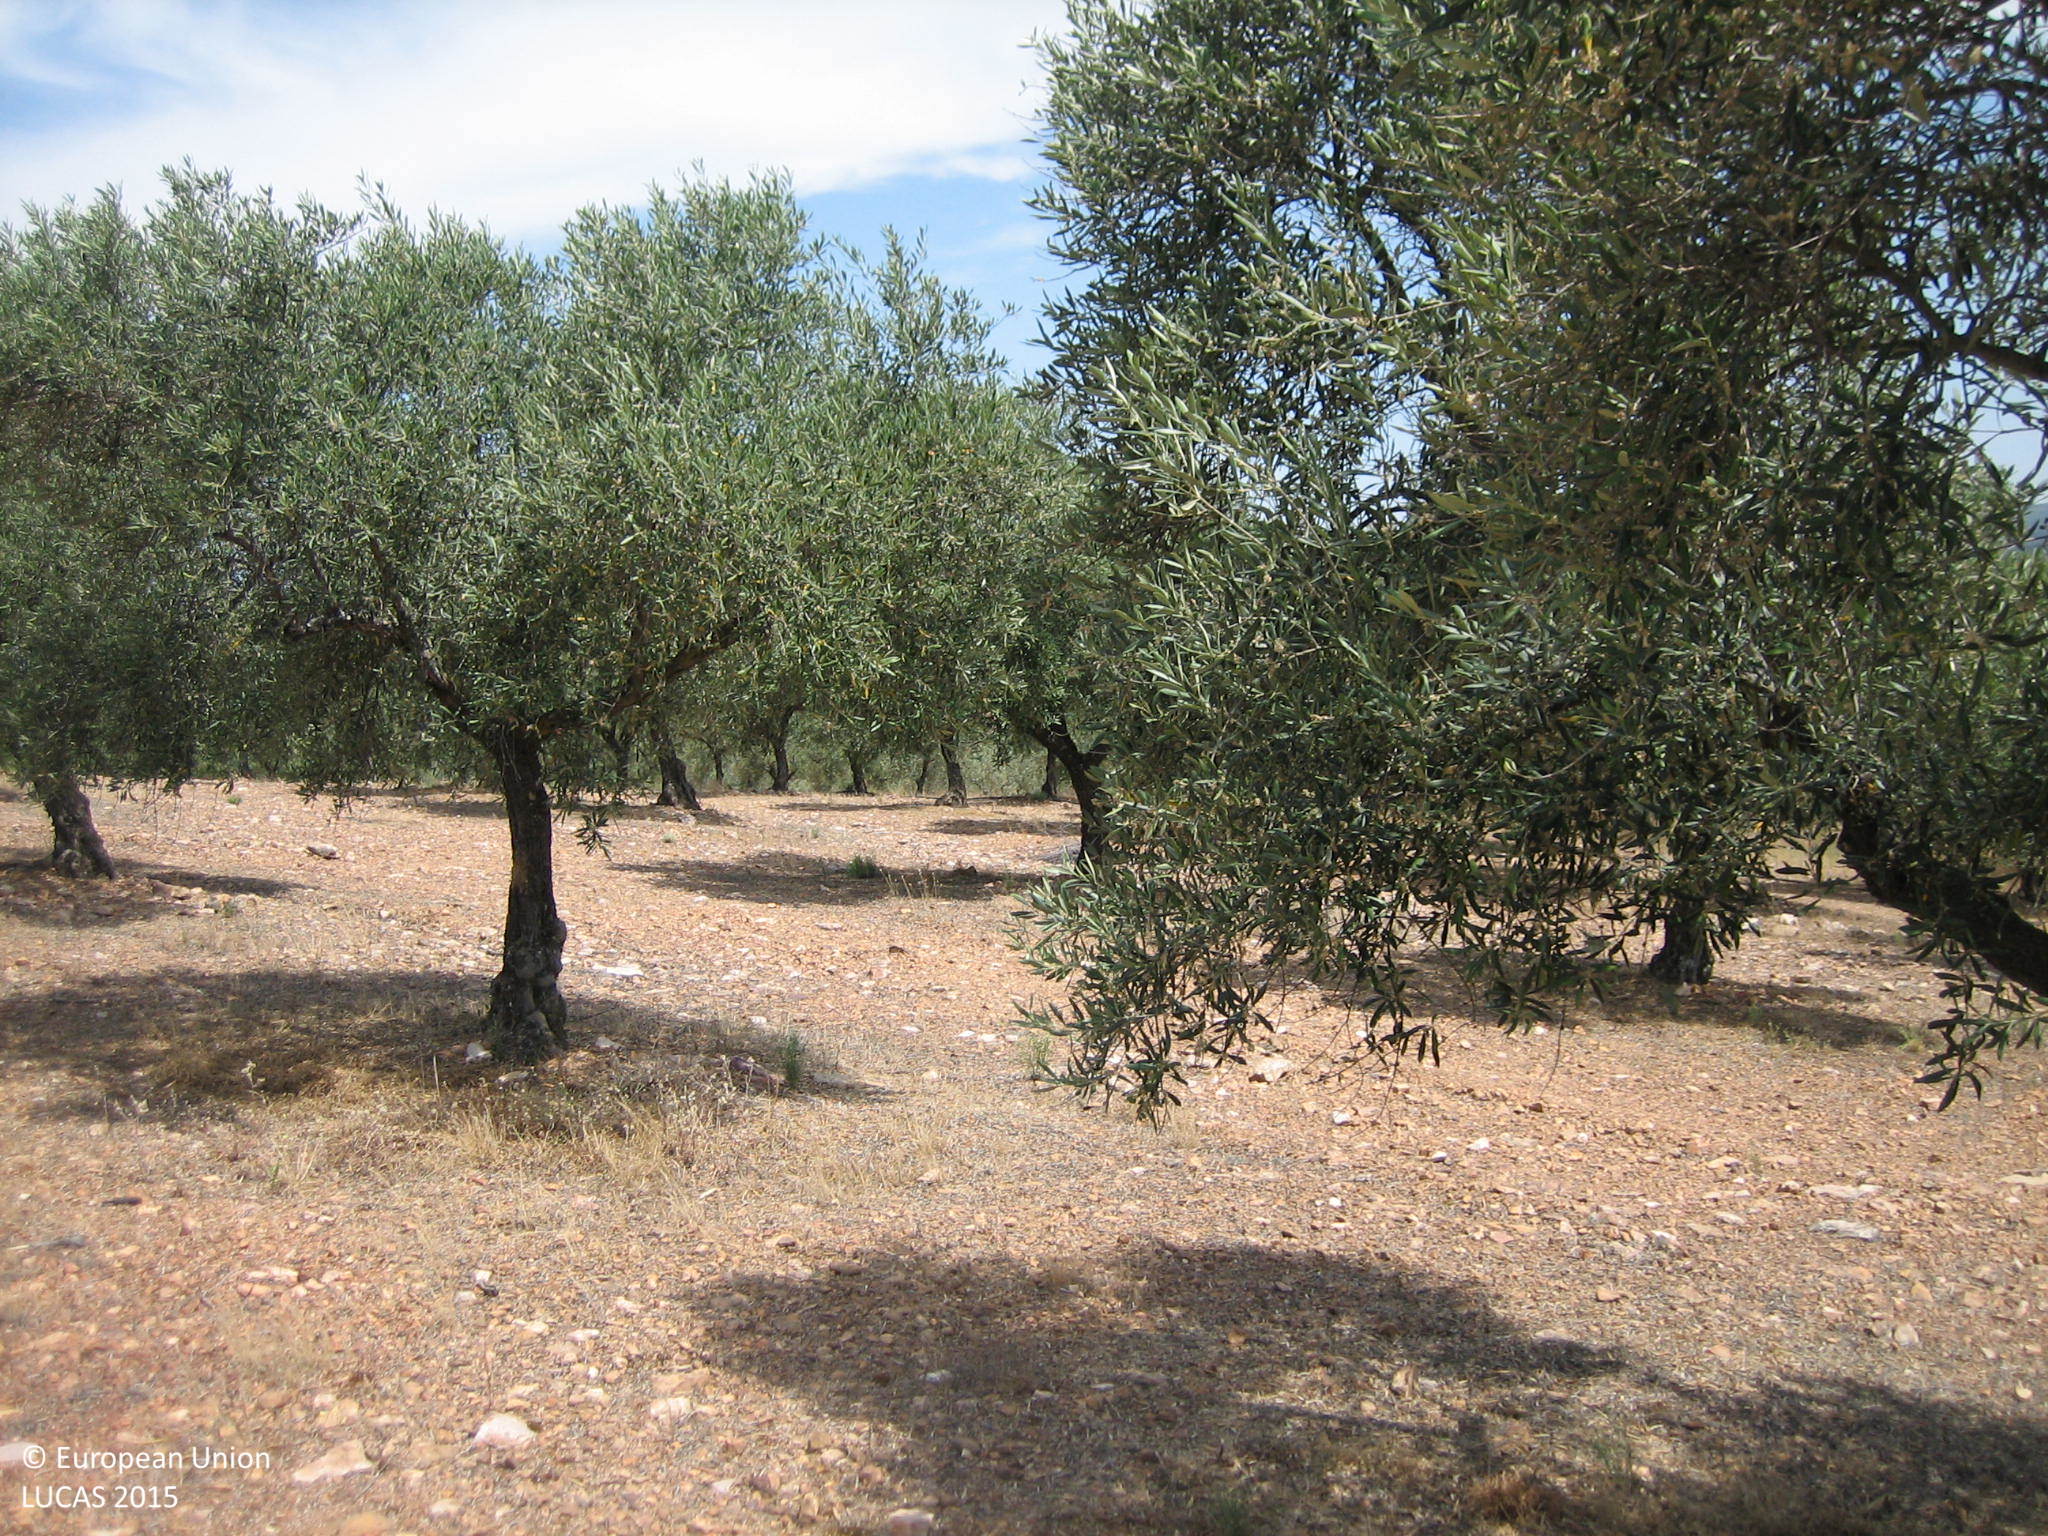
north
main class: Cropland
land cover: Olive groves
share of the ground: 25 - 50 %
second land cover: Other bare soil
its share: > 75 %
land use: Agriculture (excluding fallow land and kitchen gardens)
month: June
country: ES
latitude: 38.9734
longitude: -4.7948
